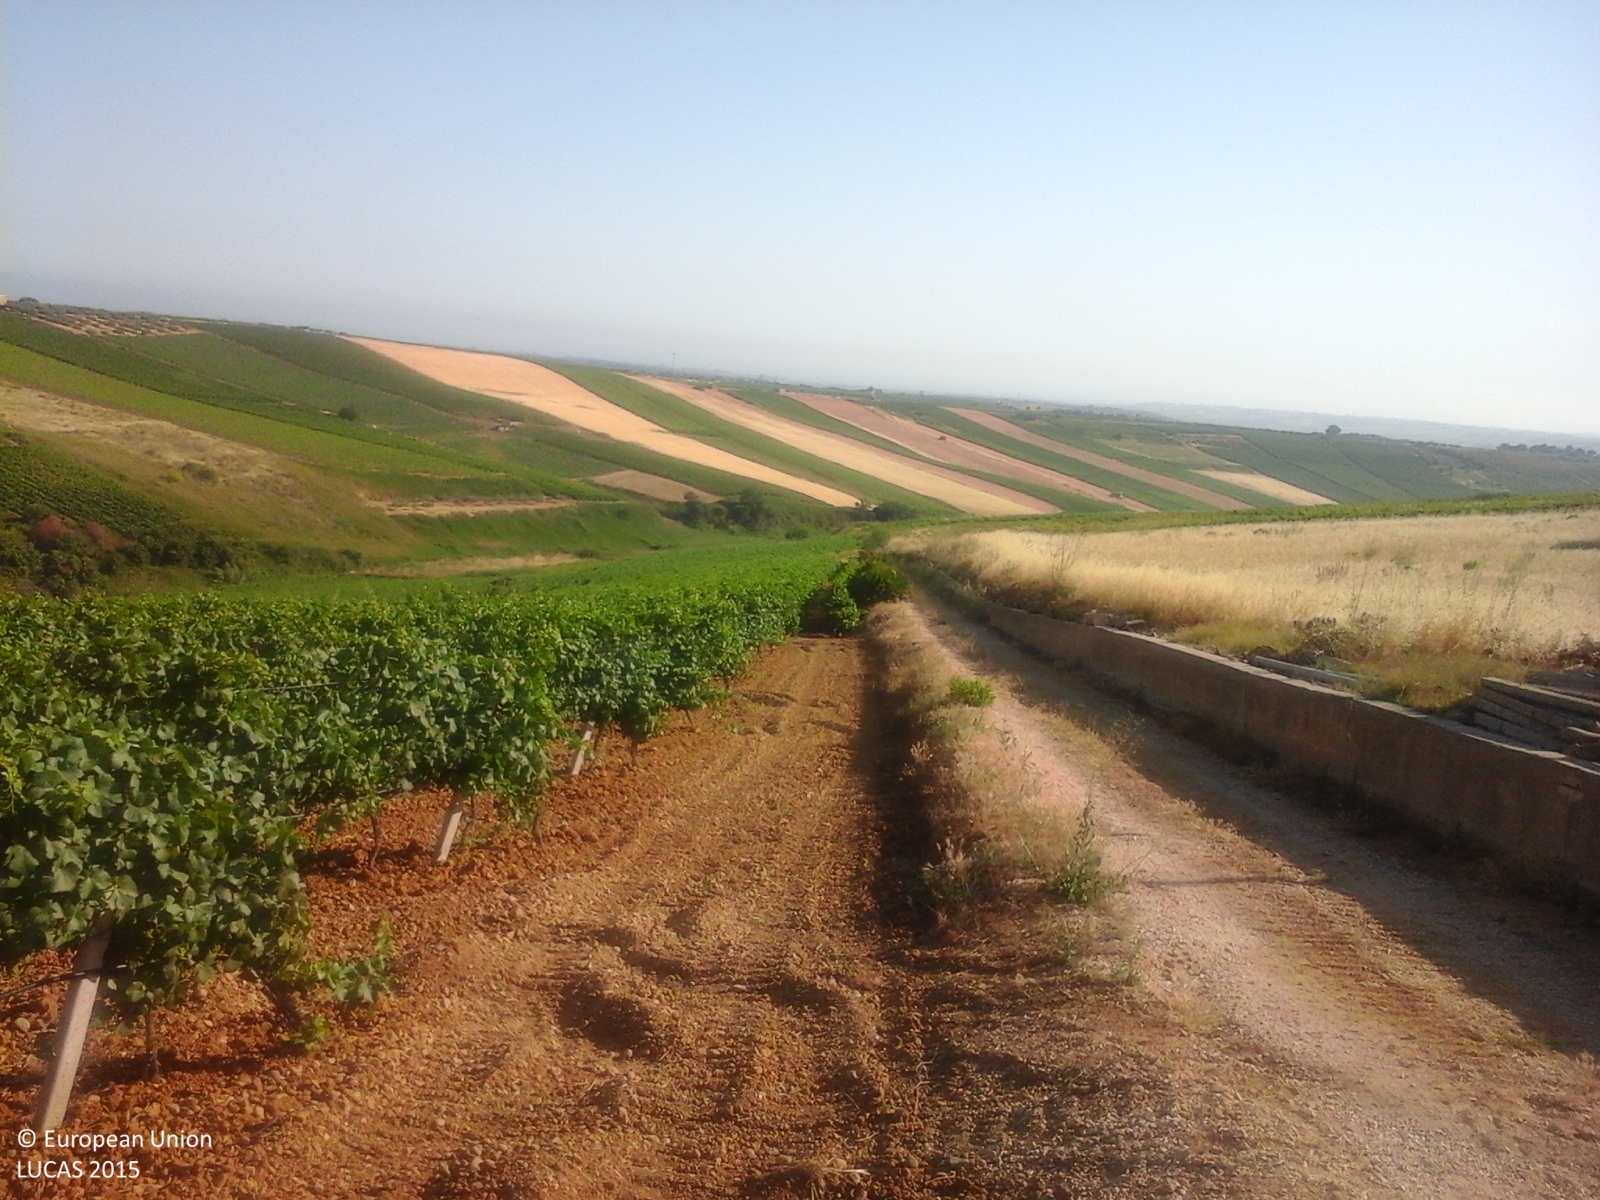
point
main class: Cropland
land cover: Vineyards
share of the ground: 25 - 50 %
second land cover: Other bare soil
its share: > 75 %
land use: Agriculture (excluding fallow land and kitchen gardens)
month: June
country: IT
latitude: 37.6484
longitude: 12.9134
